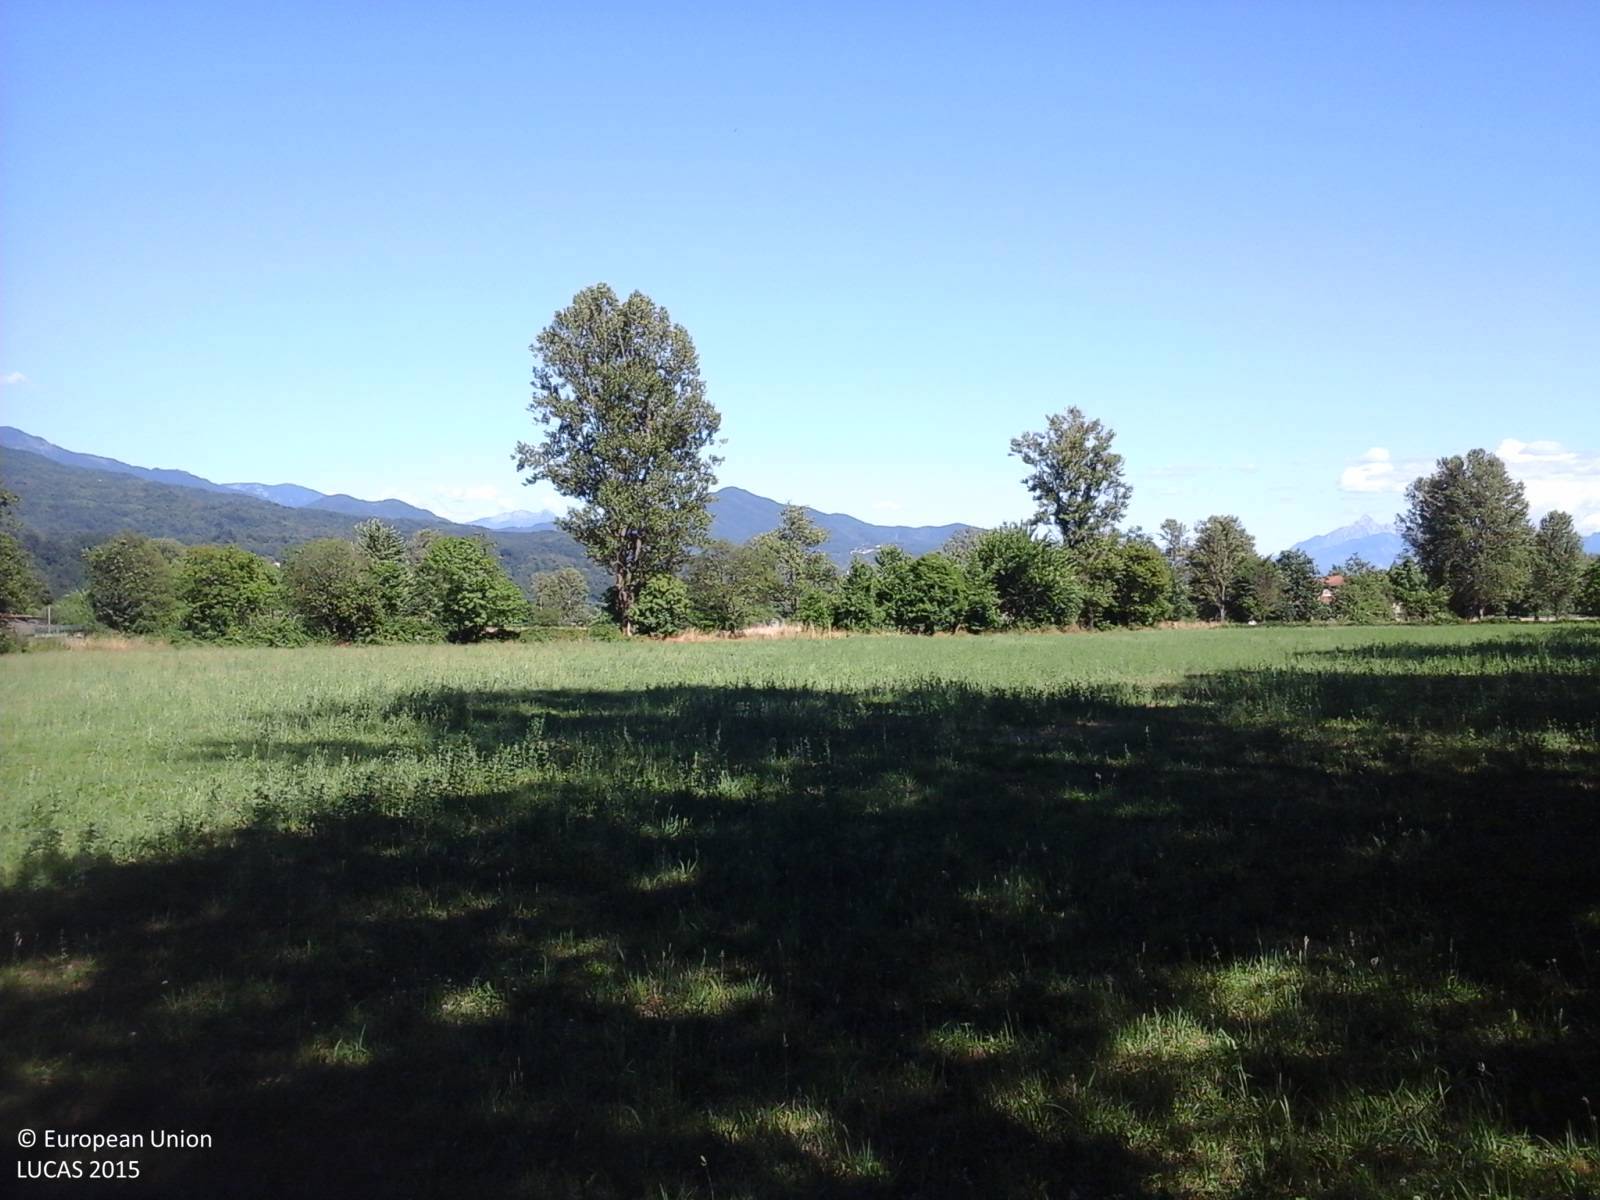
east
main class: Shrubland
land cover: Shrubland with sparse tree cover
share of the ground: > 75 %
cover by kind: shrubs 55 %, unconsolidated bare surface 40 %, broadleaved forest trees 5 %
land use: Semi-natural and natural areas not in use
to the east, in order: Shrubland with sparse tree cover; Inland fresh running water; Broadleaved woodland; Lucerne; Shrubland with sparse tree cover; Lucerne; Abandoned hedges; Tracks; Lucerne
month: June
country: IT
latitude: 44.3325
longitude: 9.9124
